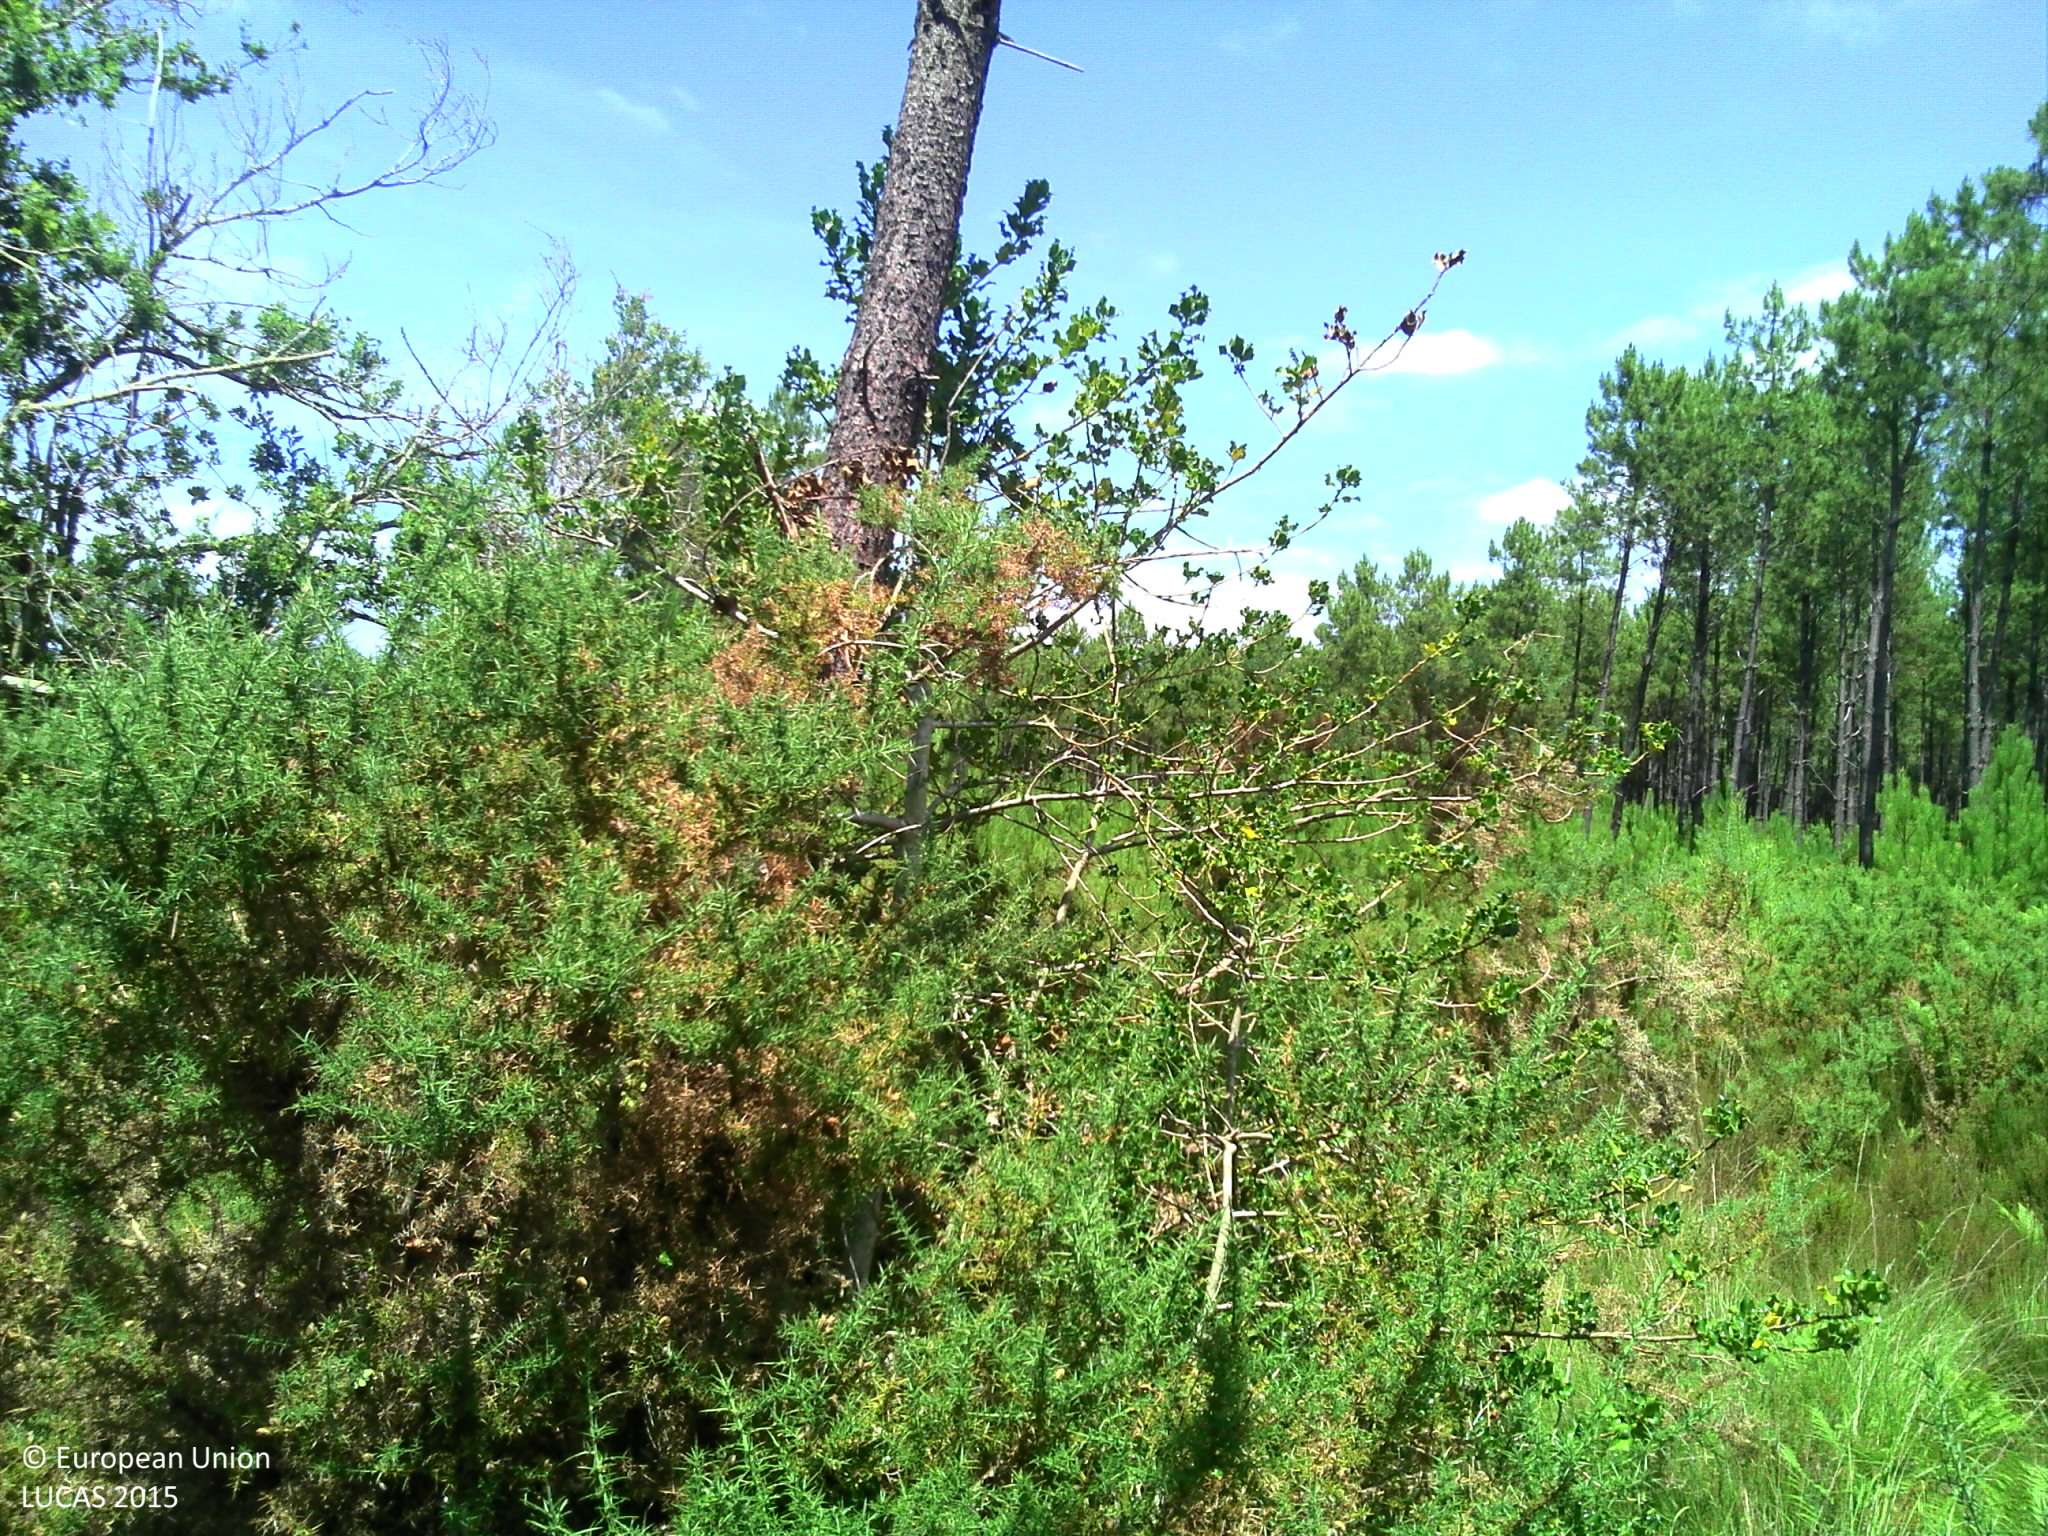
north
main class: Woodland
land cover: Pine dominated mixed woodland
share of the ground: > 75 %
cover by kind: coniferous forest trees 40 %, broadleaved forest trees 40 %, shrubs 10 %, herbaceous plants 10 %
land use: Forestry
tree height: > 5 m
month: July
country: FR
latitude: 43.9787
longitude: -1.2014
